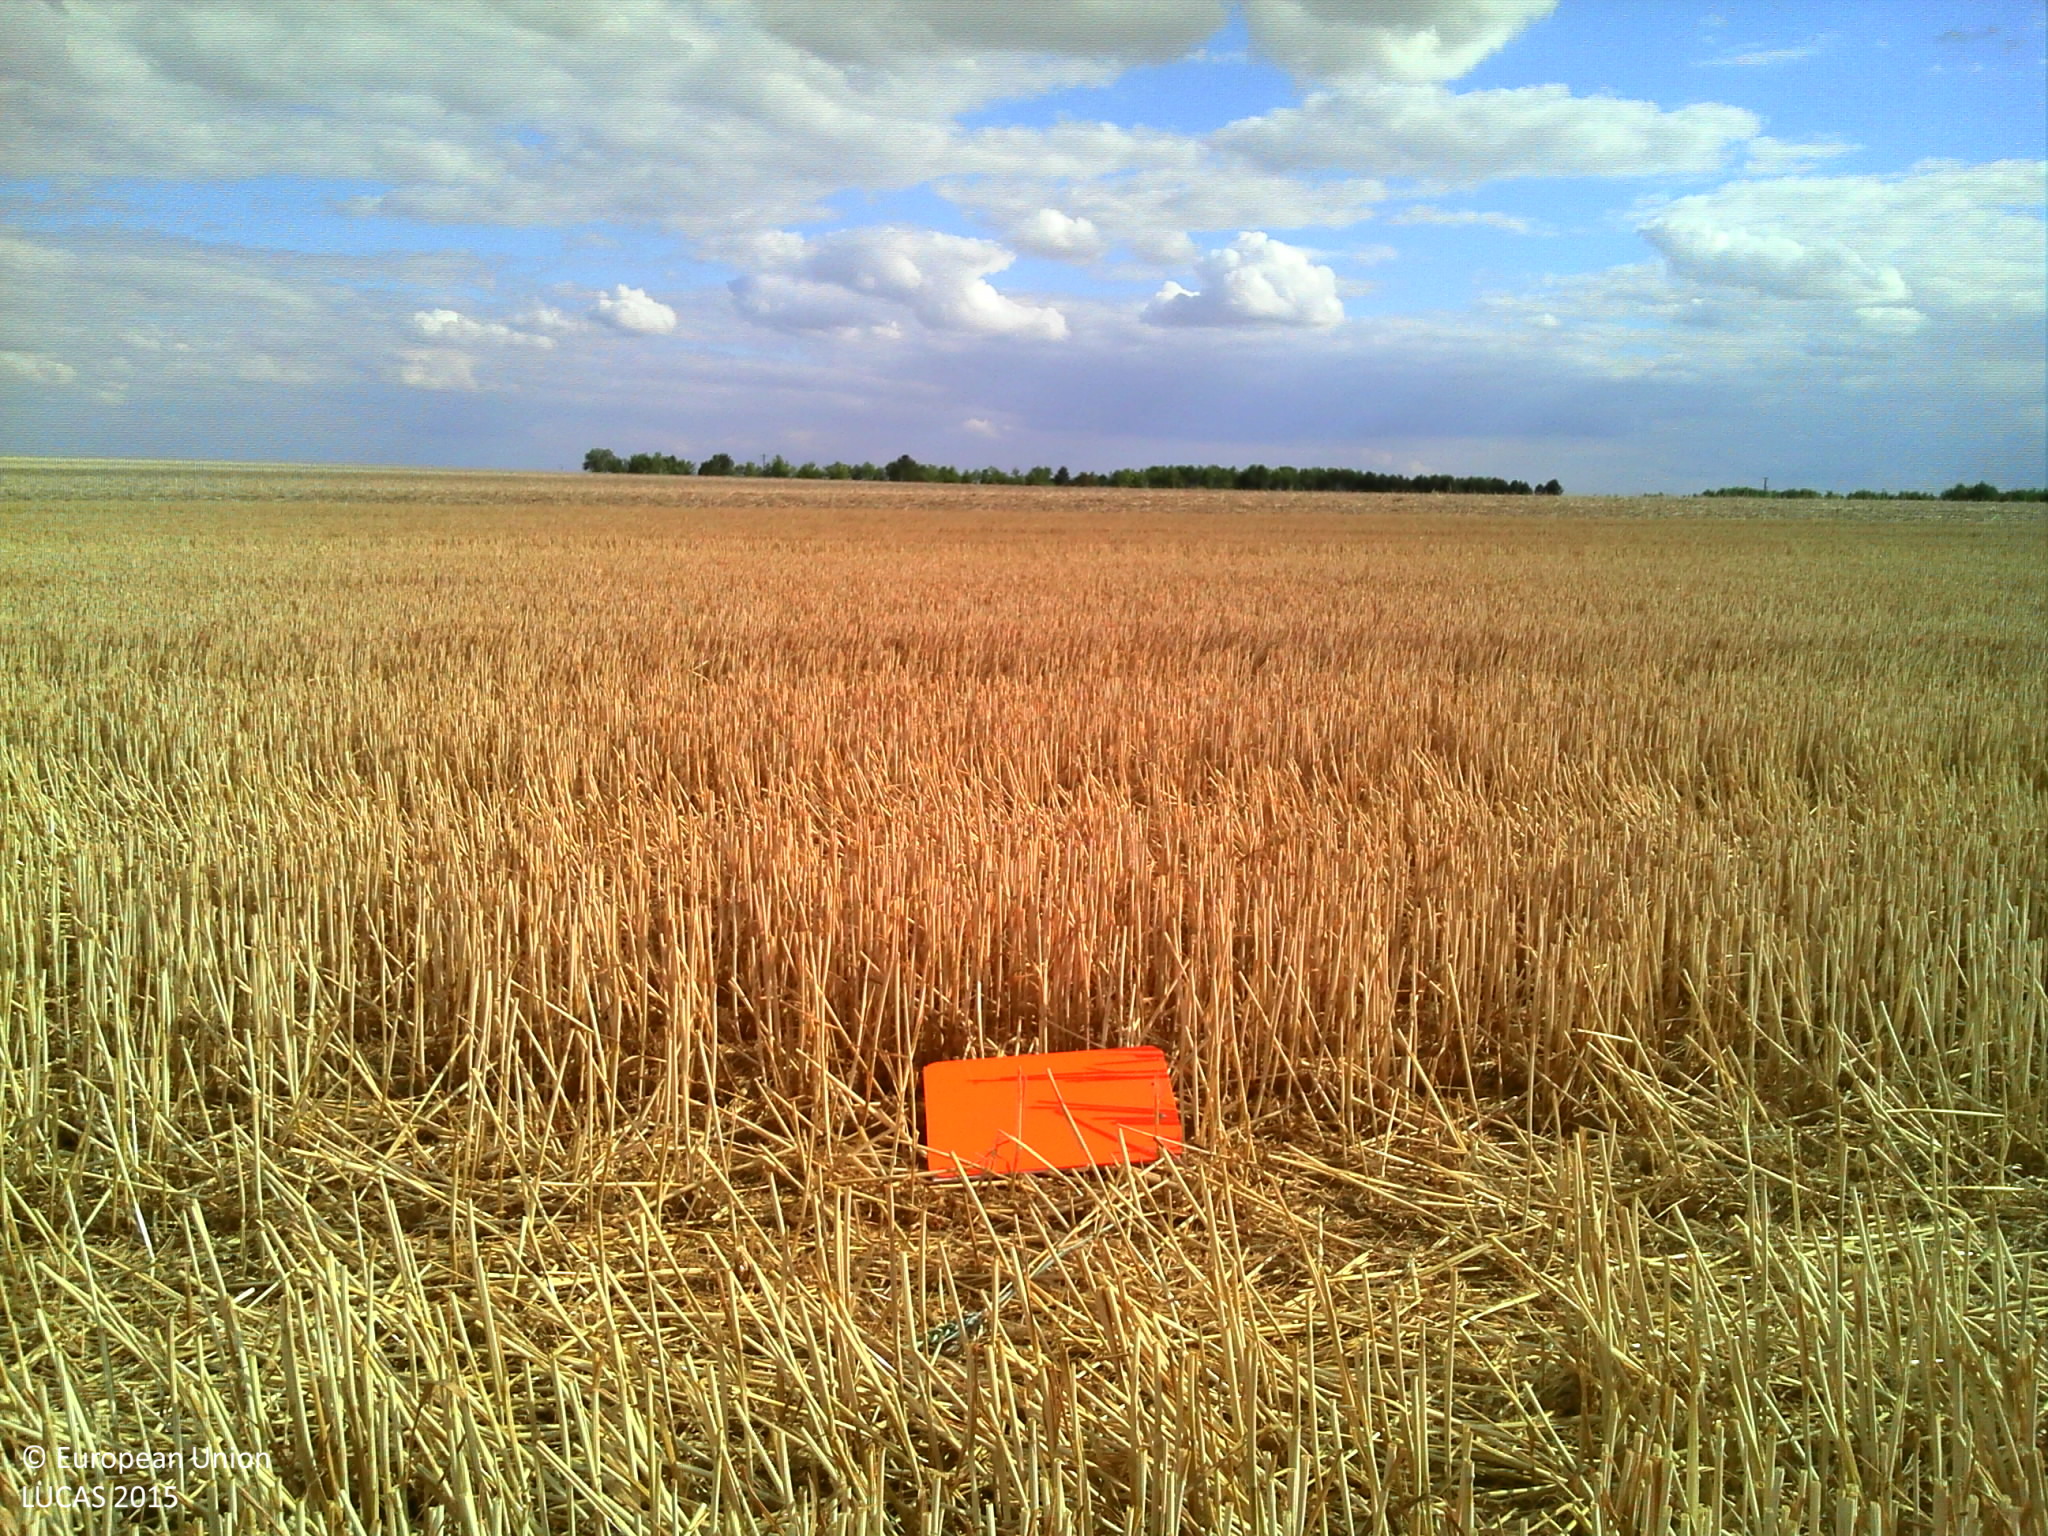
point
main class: Cropland
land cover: Common wheat
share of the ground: > 75 %
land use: Agriculture (excluding fallow land and kitchen gardens)
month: July
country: FR
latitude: 49.1019
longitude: 4.2569
